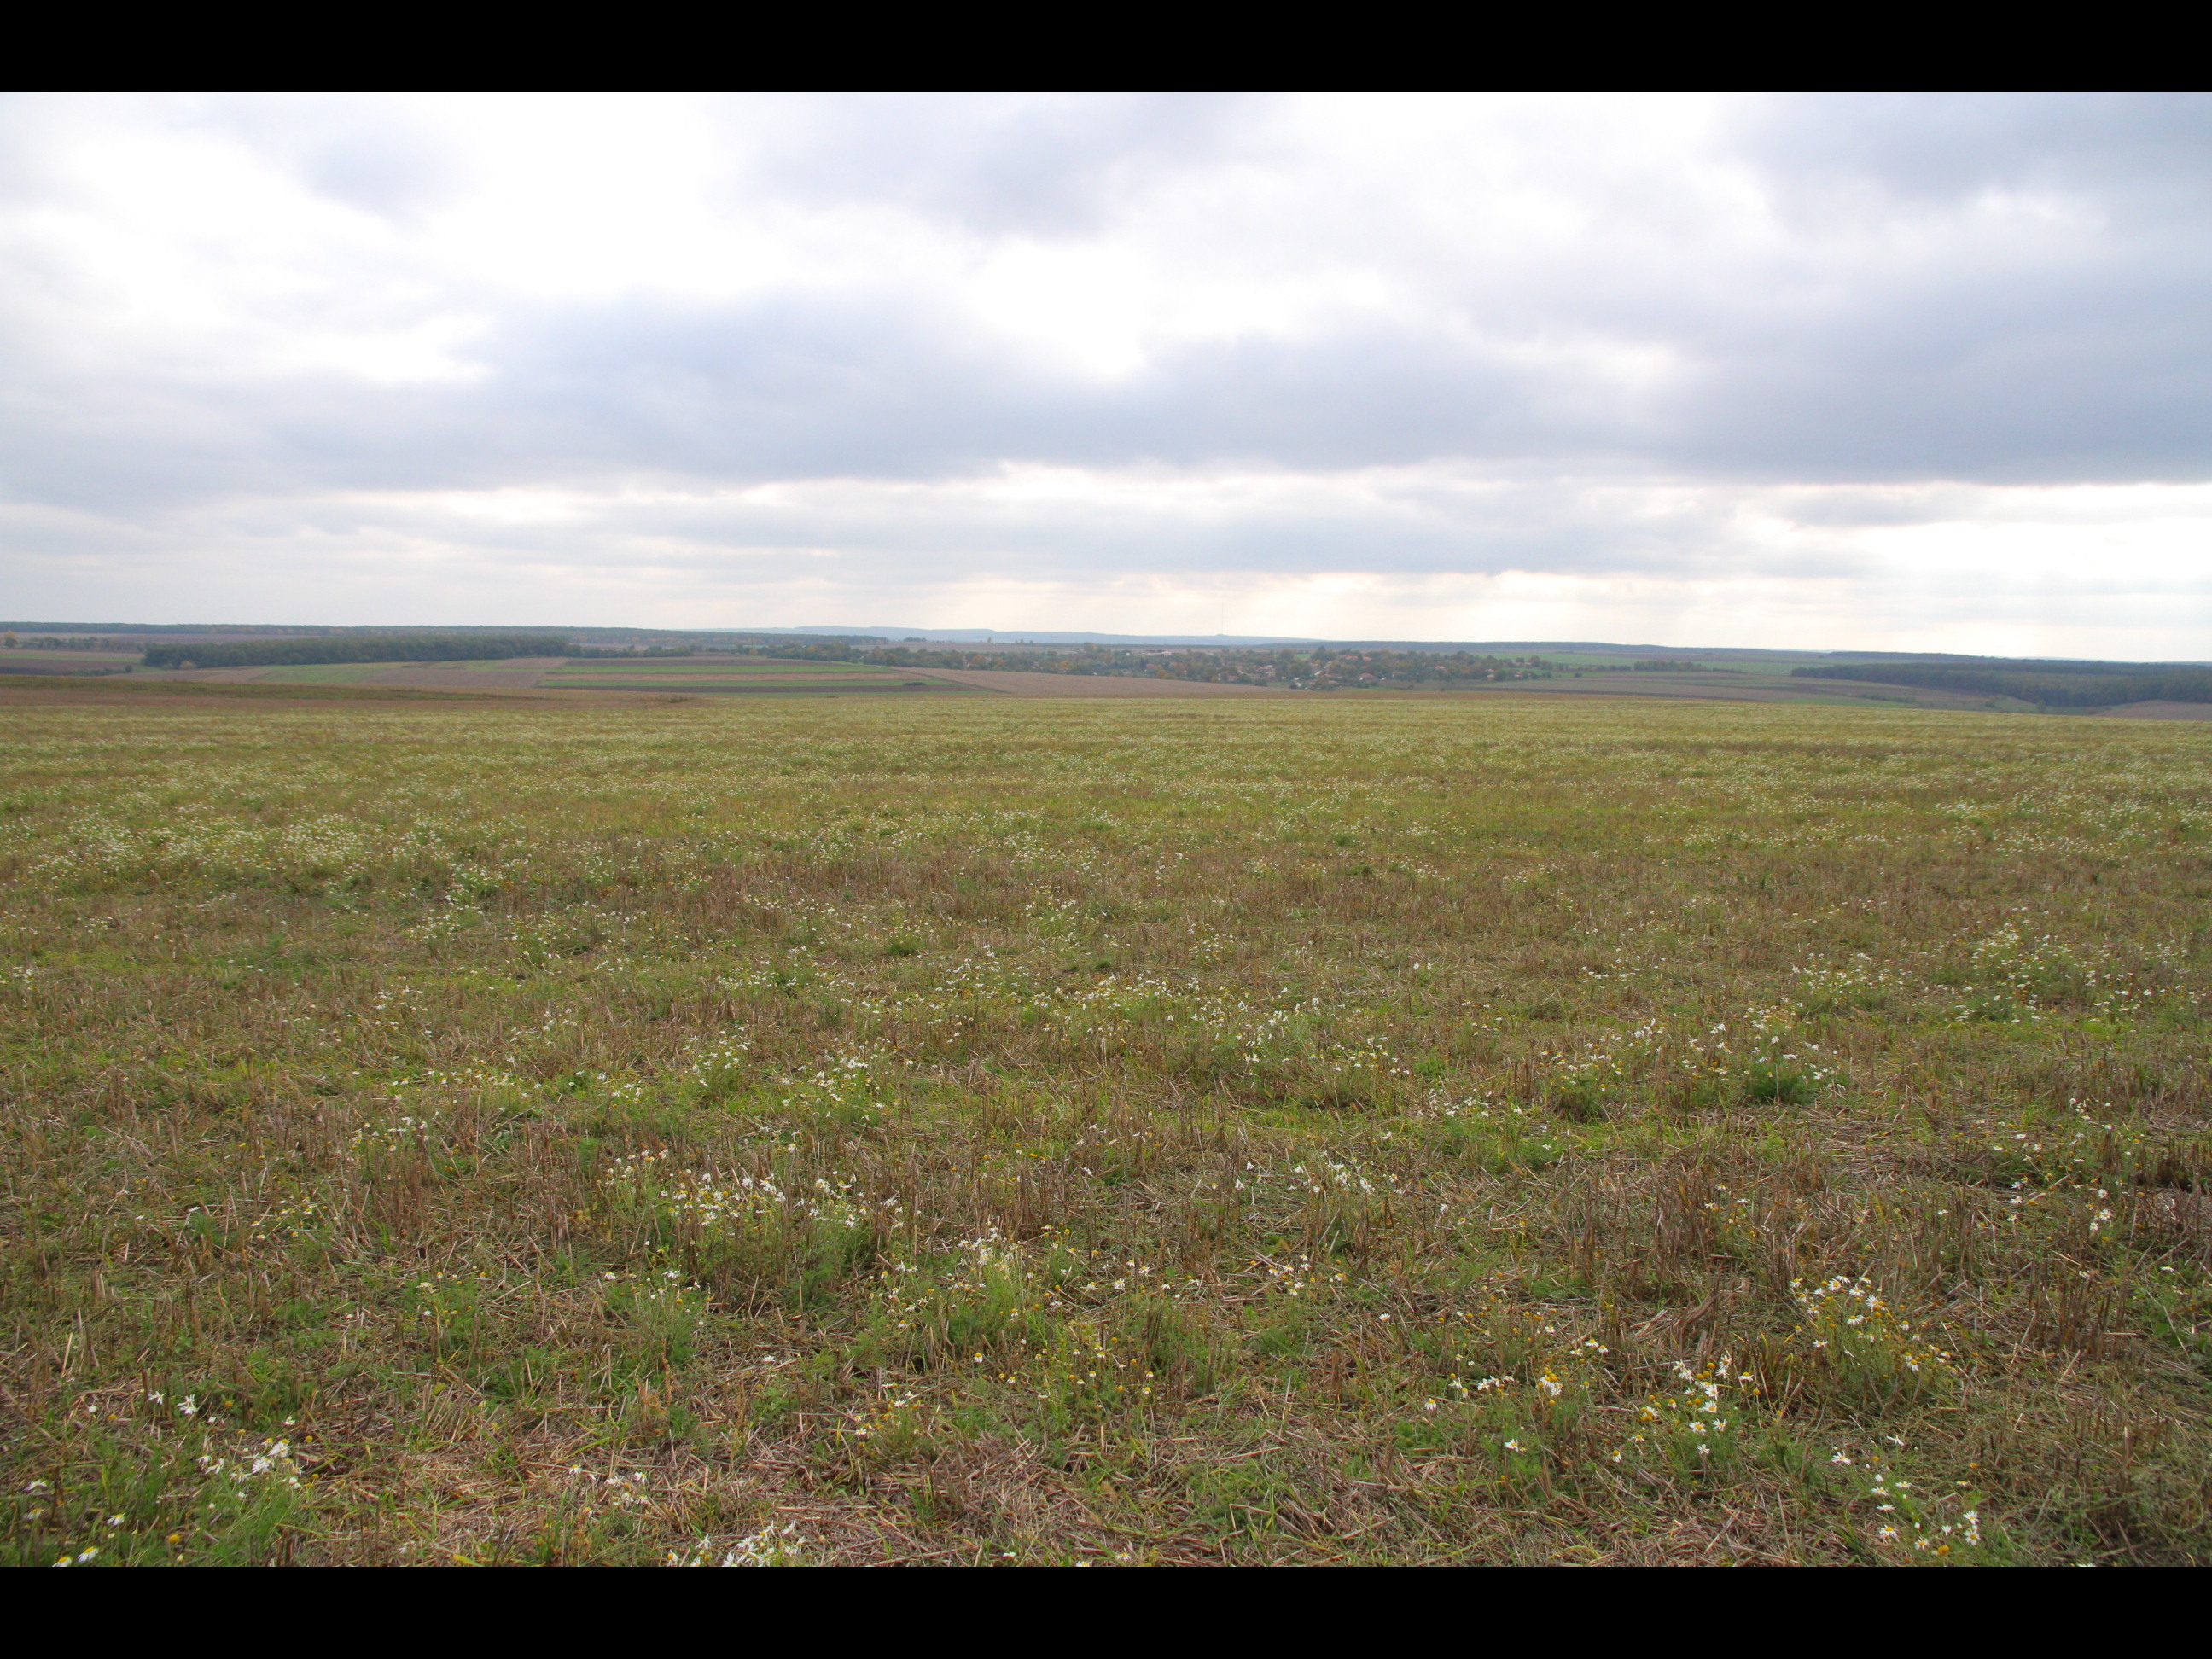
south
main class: Cropland
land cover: Common wheat
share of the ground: < 10 %
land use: Agriculture (excluding fallow land and kitchen gardens)
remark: Harvested field
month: October
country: BG
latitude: 43.6054
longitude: 26.9542
